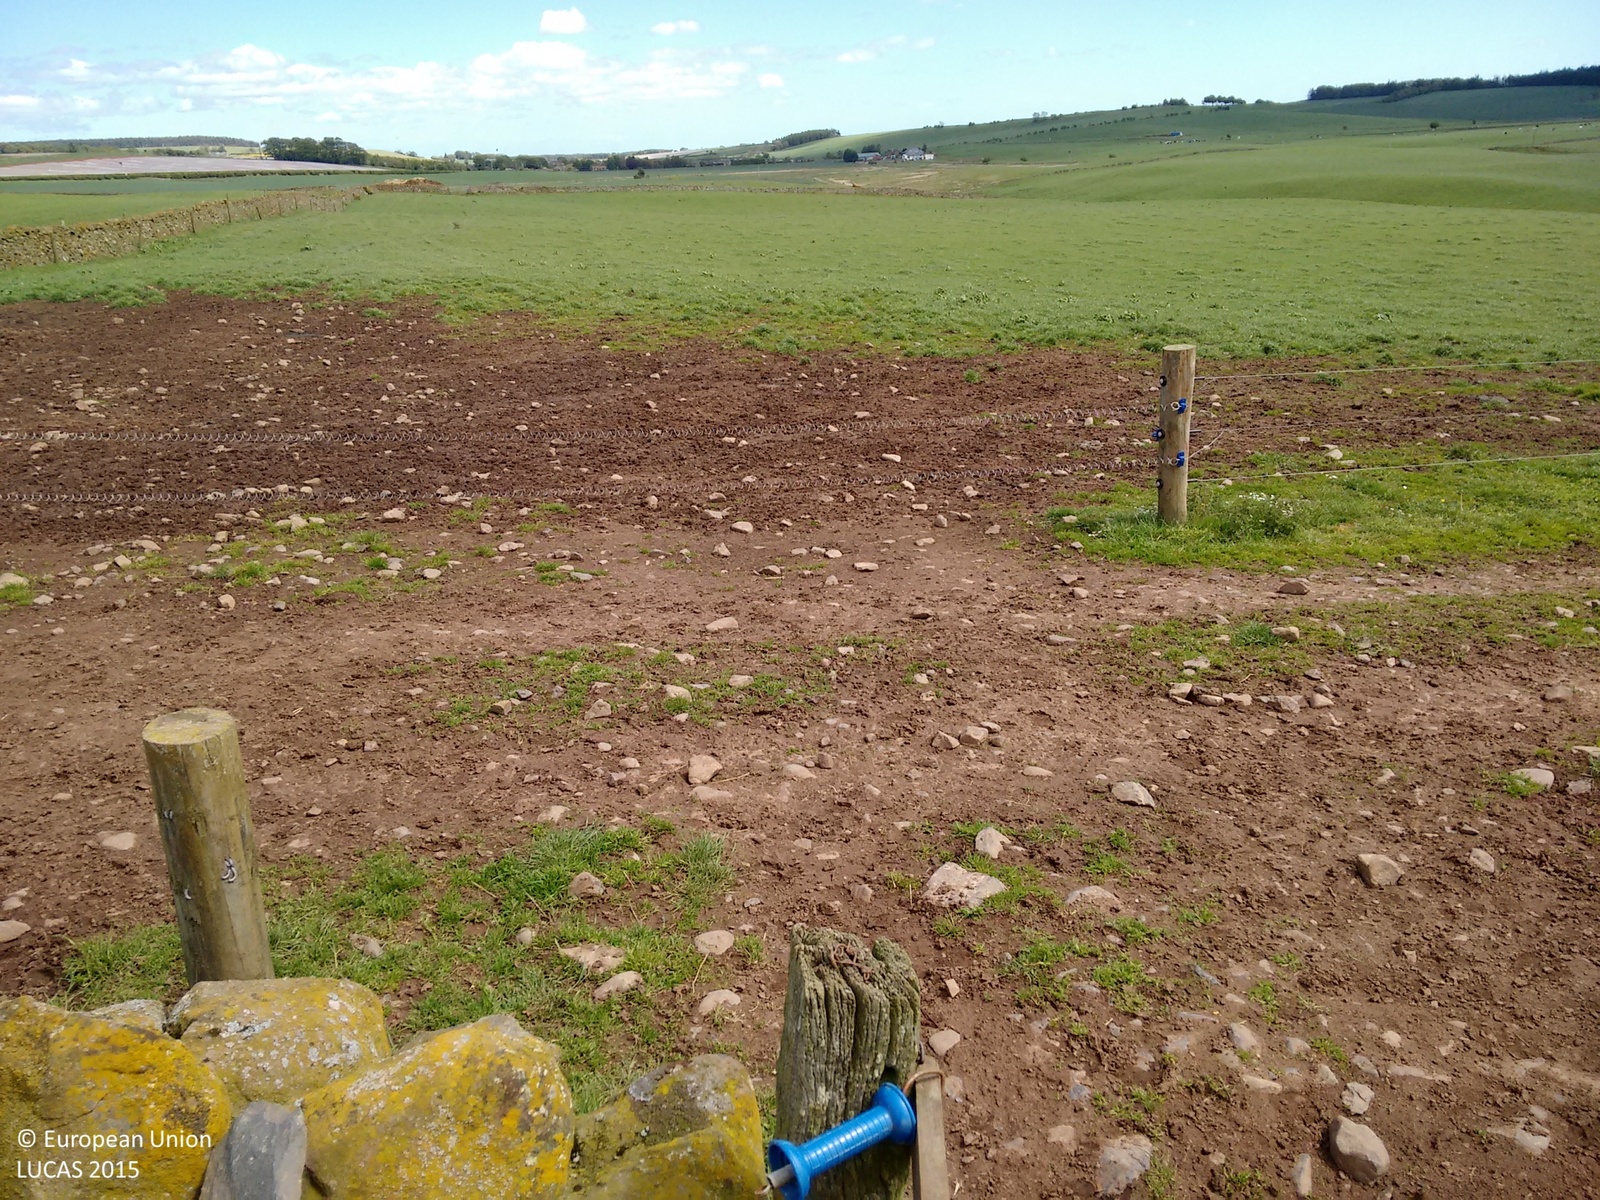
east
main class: Grassland
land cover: Grassland without tree/shrub cover
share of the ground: > 75 %
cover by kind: herbaceous plants 100 %
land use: Agriculture (excluding fallow land and kitchen gardens)
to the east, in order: Grassland without tree/shrub cover; Fences; Grass margins; Fences; Grassland without tree/shrub cover
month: June
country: GB
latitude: 55.7023
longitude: -2.4877
